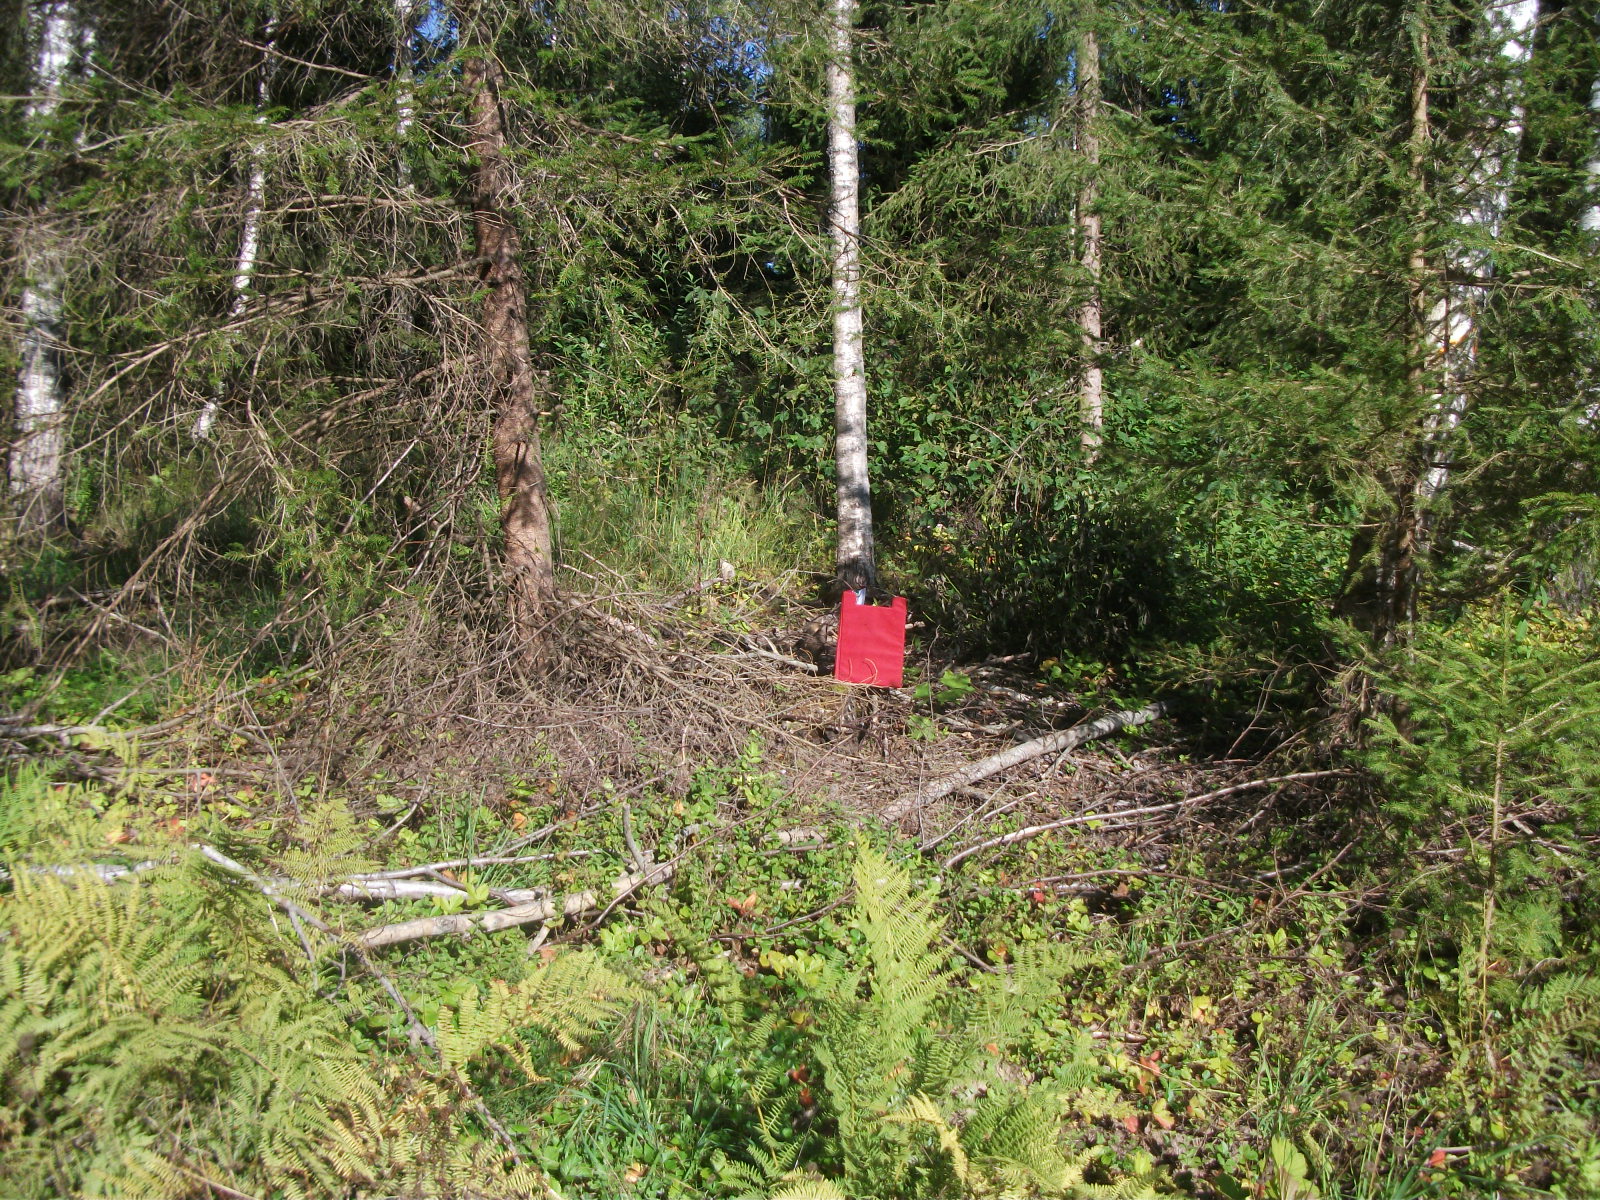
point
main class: Woodland
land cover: Spruce dominated mixed woodland
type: hemiboreal forest and nemoral coniferous forest and mixed broadleaved-coniferous forest
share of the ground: 25 - 50 %
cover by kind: shrubs 40 %, broadleaved forest trees 30 %, coniferous forest trees 20 %, herbaceous plants 10 %
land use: Forestry
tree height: > 5 m
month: August
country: LV
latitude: 56.6512
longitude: 26.2378
